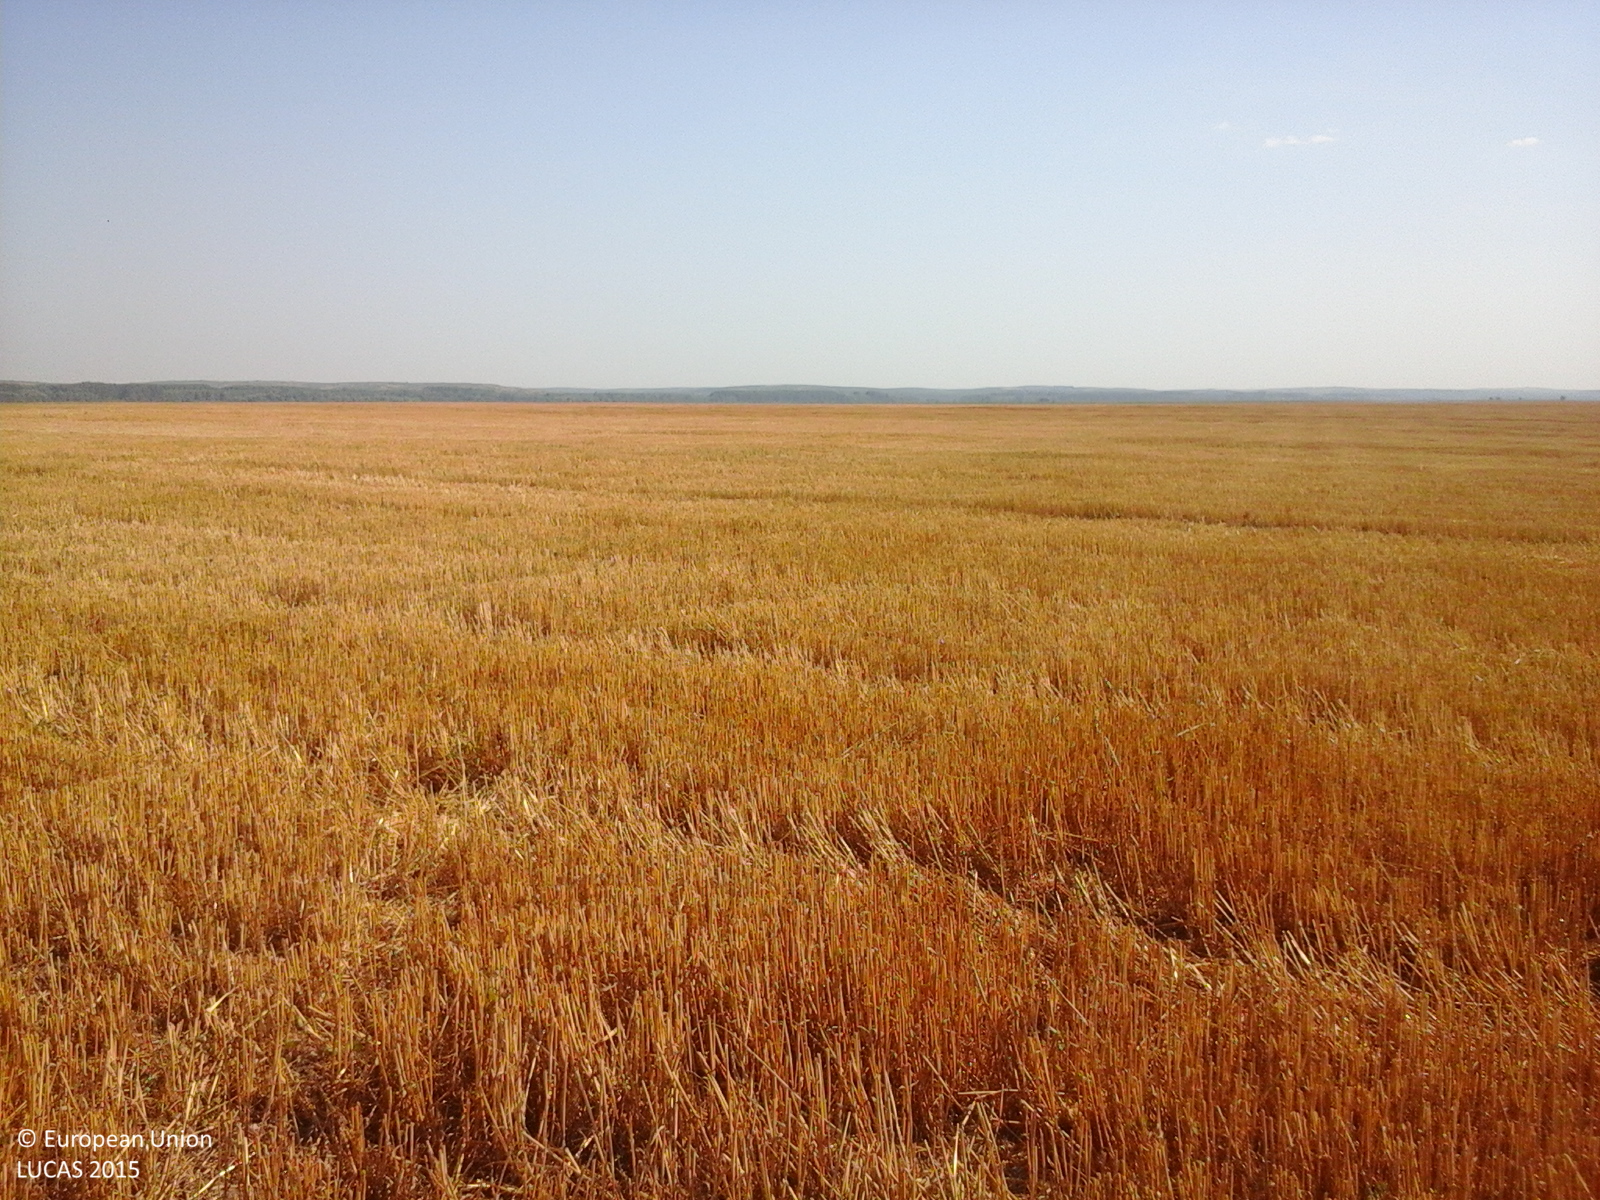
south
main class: Cropland
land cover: Common wheat
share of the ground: < 10 %
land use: Agriculture (excluding fallow land and kitchen gardens)
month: July
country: RO
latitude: 44.3325
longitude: 27.9761
